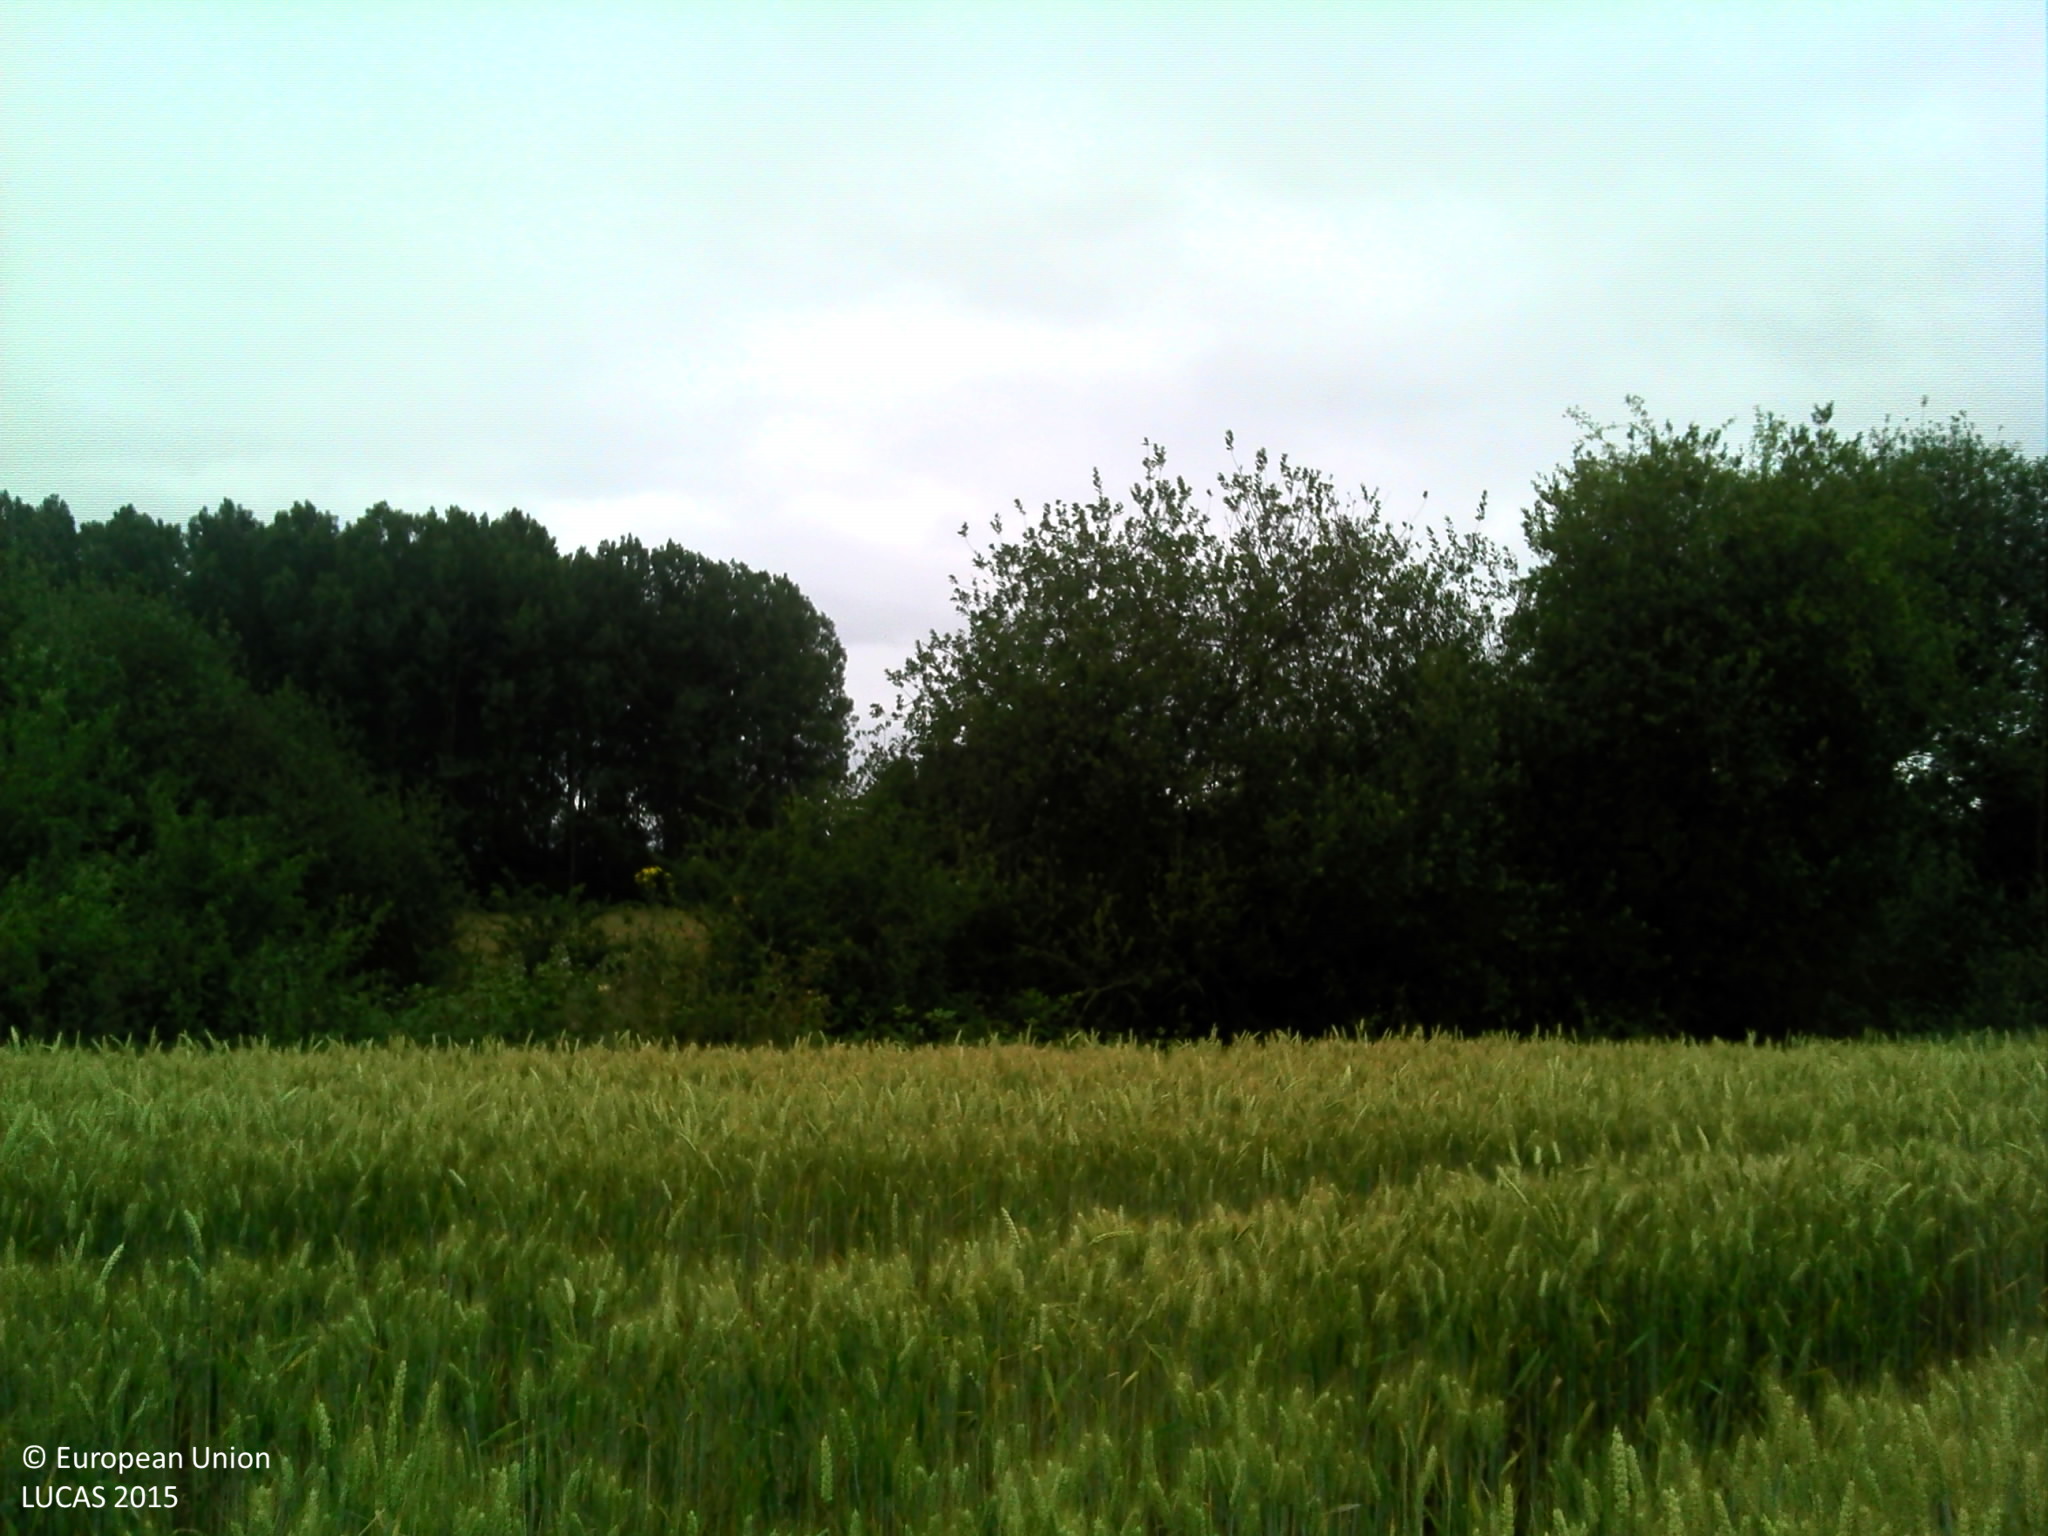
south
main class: Cropland
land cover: Common wheat
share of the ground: > 75 %
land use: Agriculture (excluding fallow land and kitchen gardens)
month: June
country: FR
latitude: 48.1284
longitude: 0.1786
